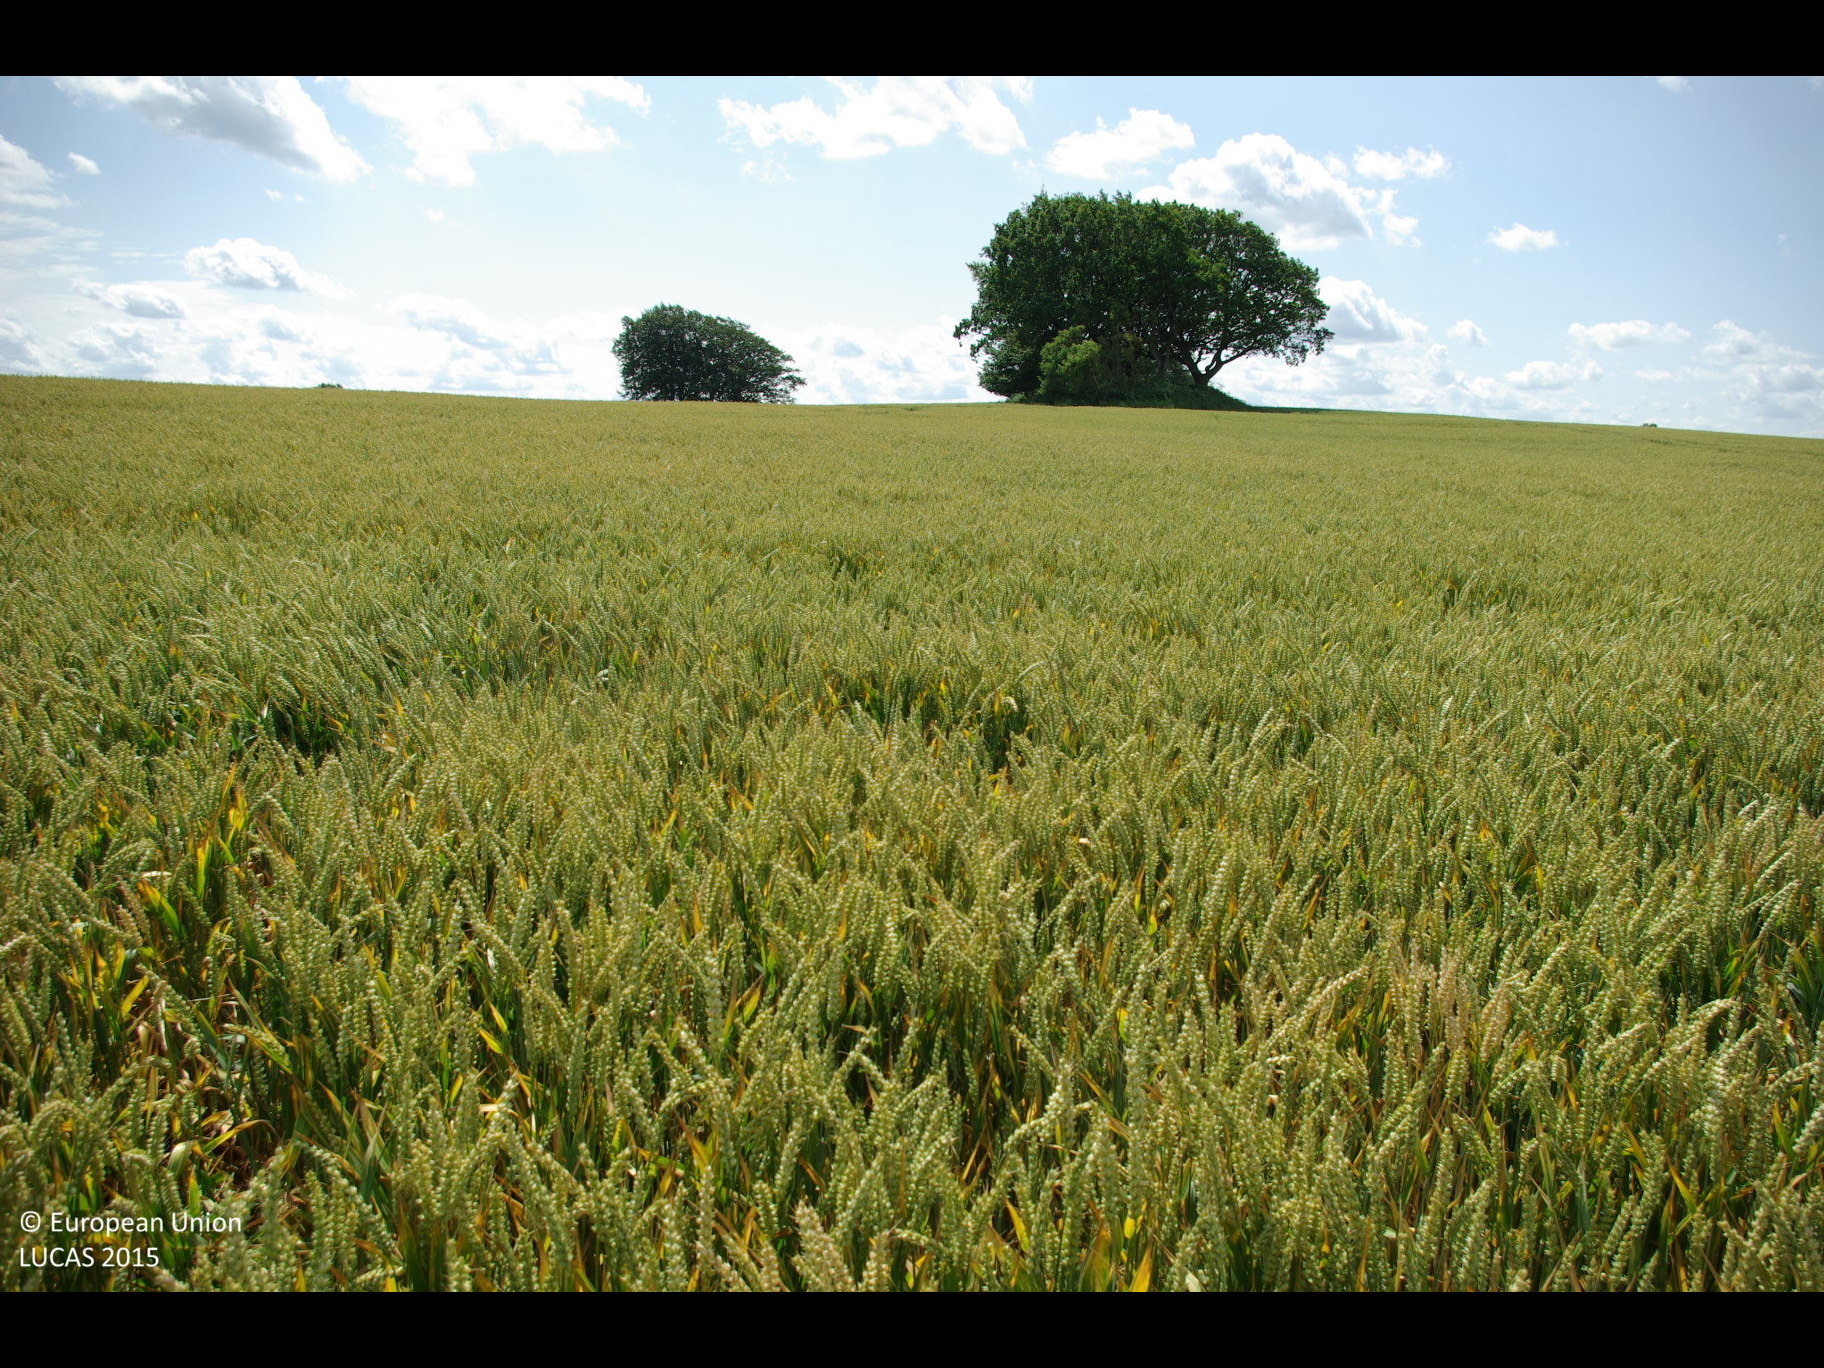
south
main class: Cropland
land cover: Common wheat
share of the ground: > 75 %
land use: Agriculture (excluding fallow land and kitchen gardens)
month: July
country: DE
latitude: 54.5341
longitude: 9.9537
